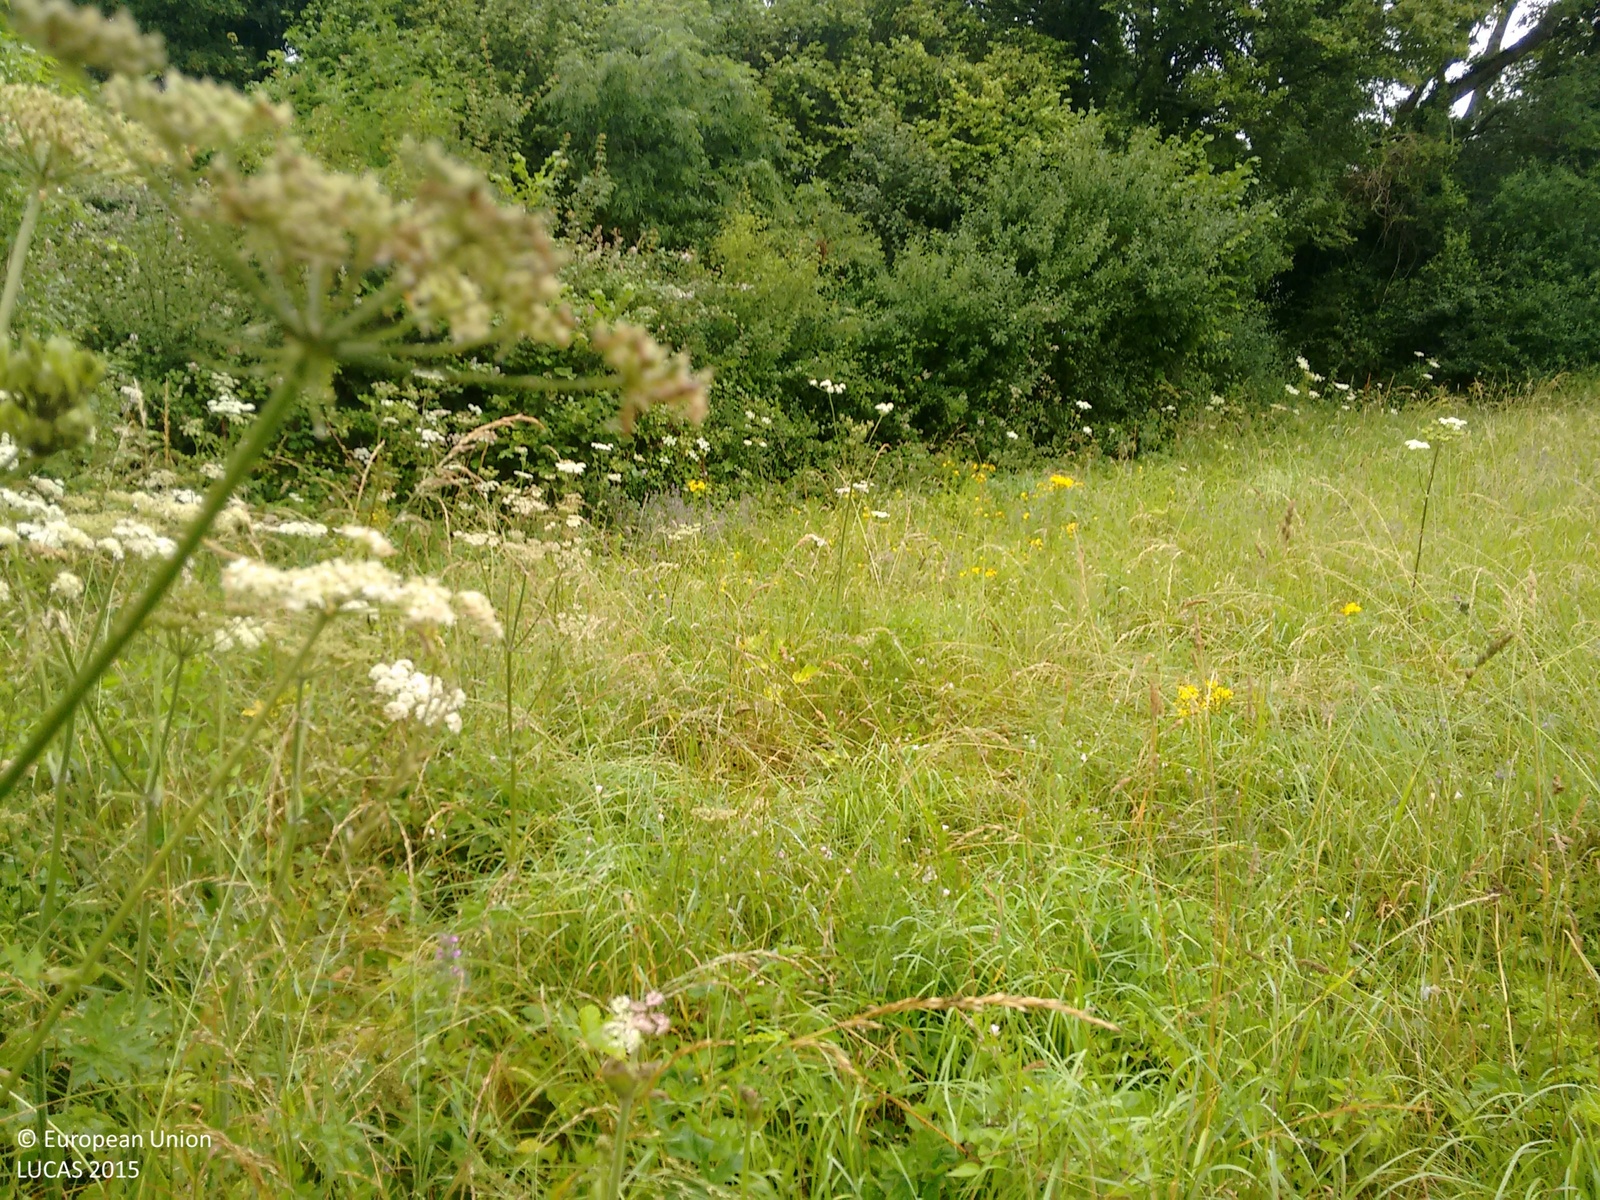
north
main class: Woodland
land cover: Broadleaved woodland
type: mesophytic deciduous forest
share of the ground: > 75 %
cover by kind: broadleaved forest trees 100 %
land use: Agriculture (excluding fallow land and kitchen gardens)
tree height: > 5 m
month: July
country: GB
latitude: 51.0411
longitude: -1.0701
